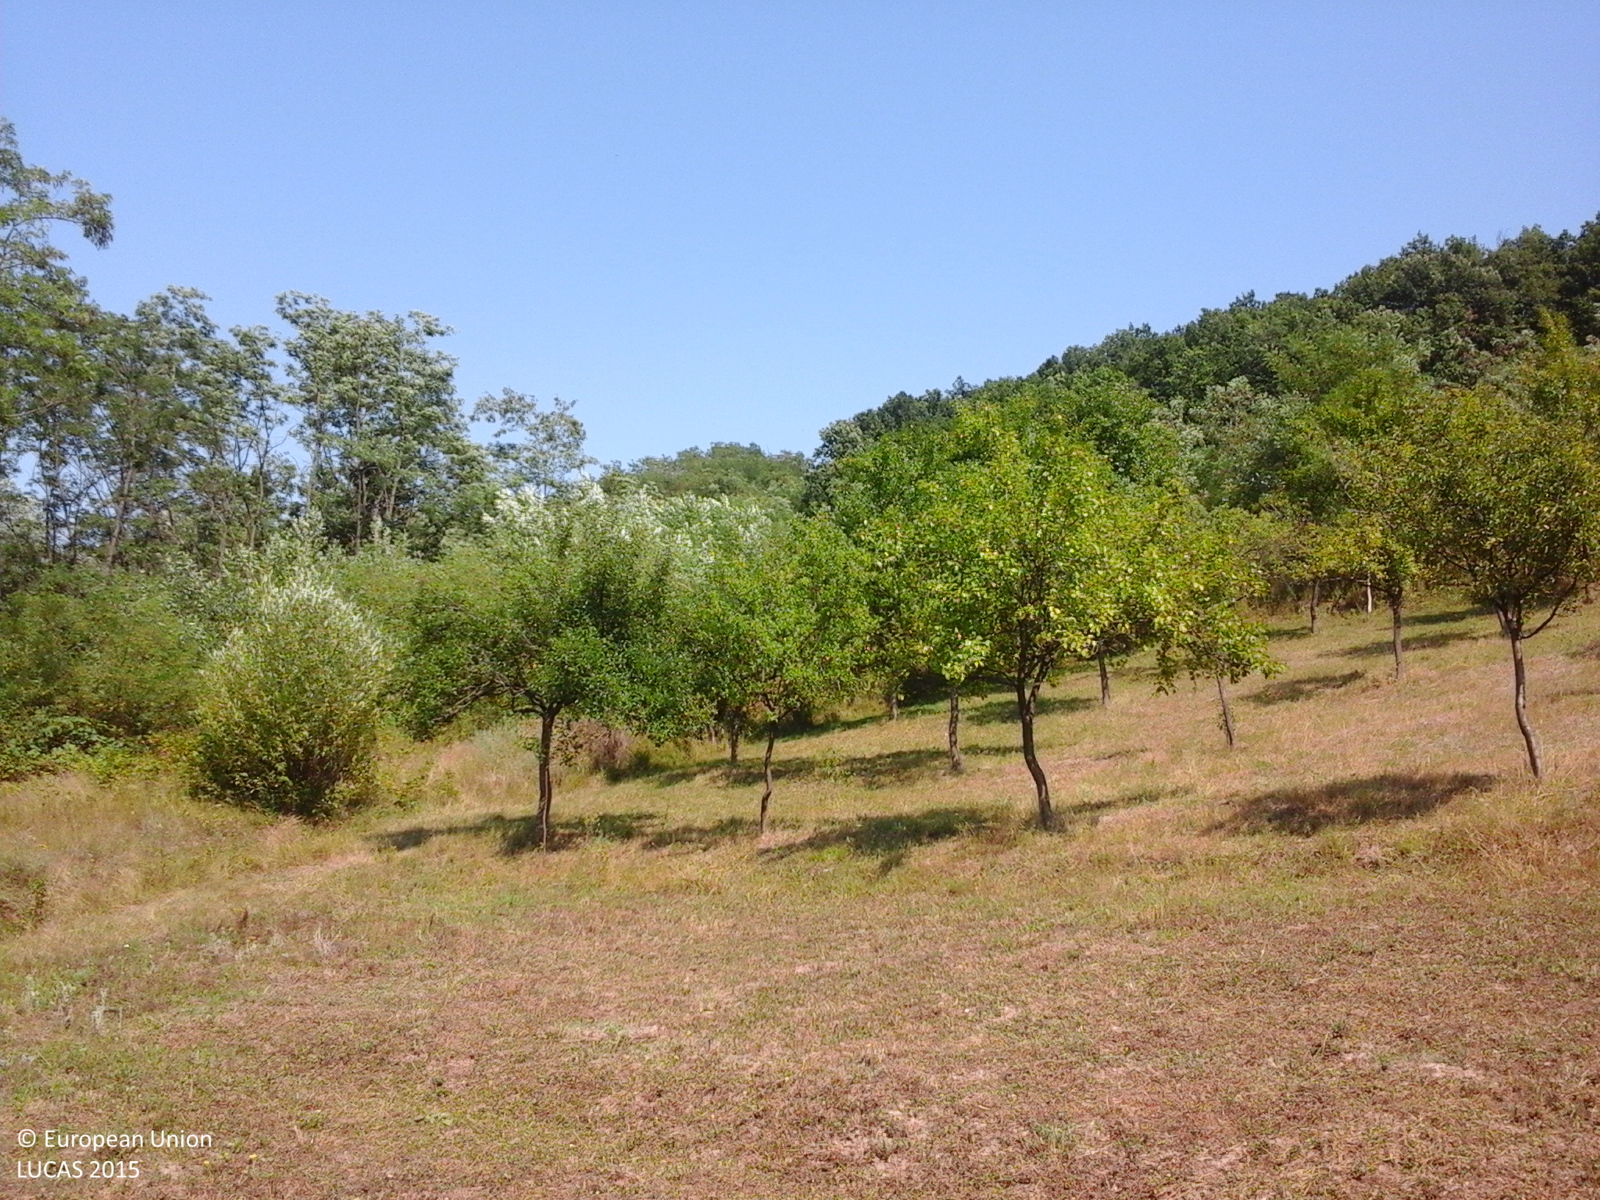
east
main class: Grassland
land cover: Grassland without tree/shrub cover
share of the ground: 50 - 75 %
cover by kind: herbaceous plants 100 %
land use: Agriculture (excluding fallow land and kitchen gardens)
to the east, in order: Grassland without tree/shrub cover; Other fruit trees and berries; Single bushes/trees; Spontaneously vegetated surfaces; Lines of trees; Spontaneously vegetated surfaces; Broadleaved woodland
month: July
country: RO
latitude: 44.8713
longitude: 24.4395
